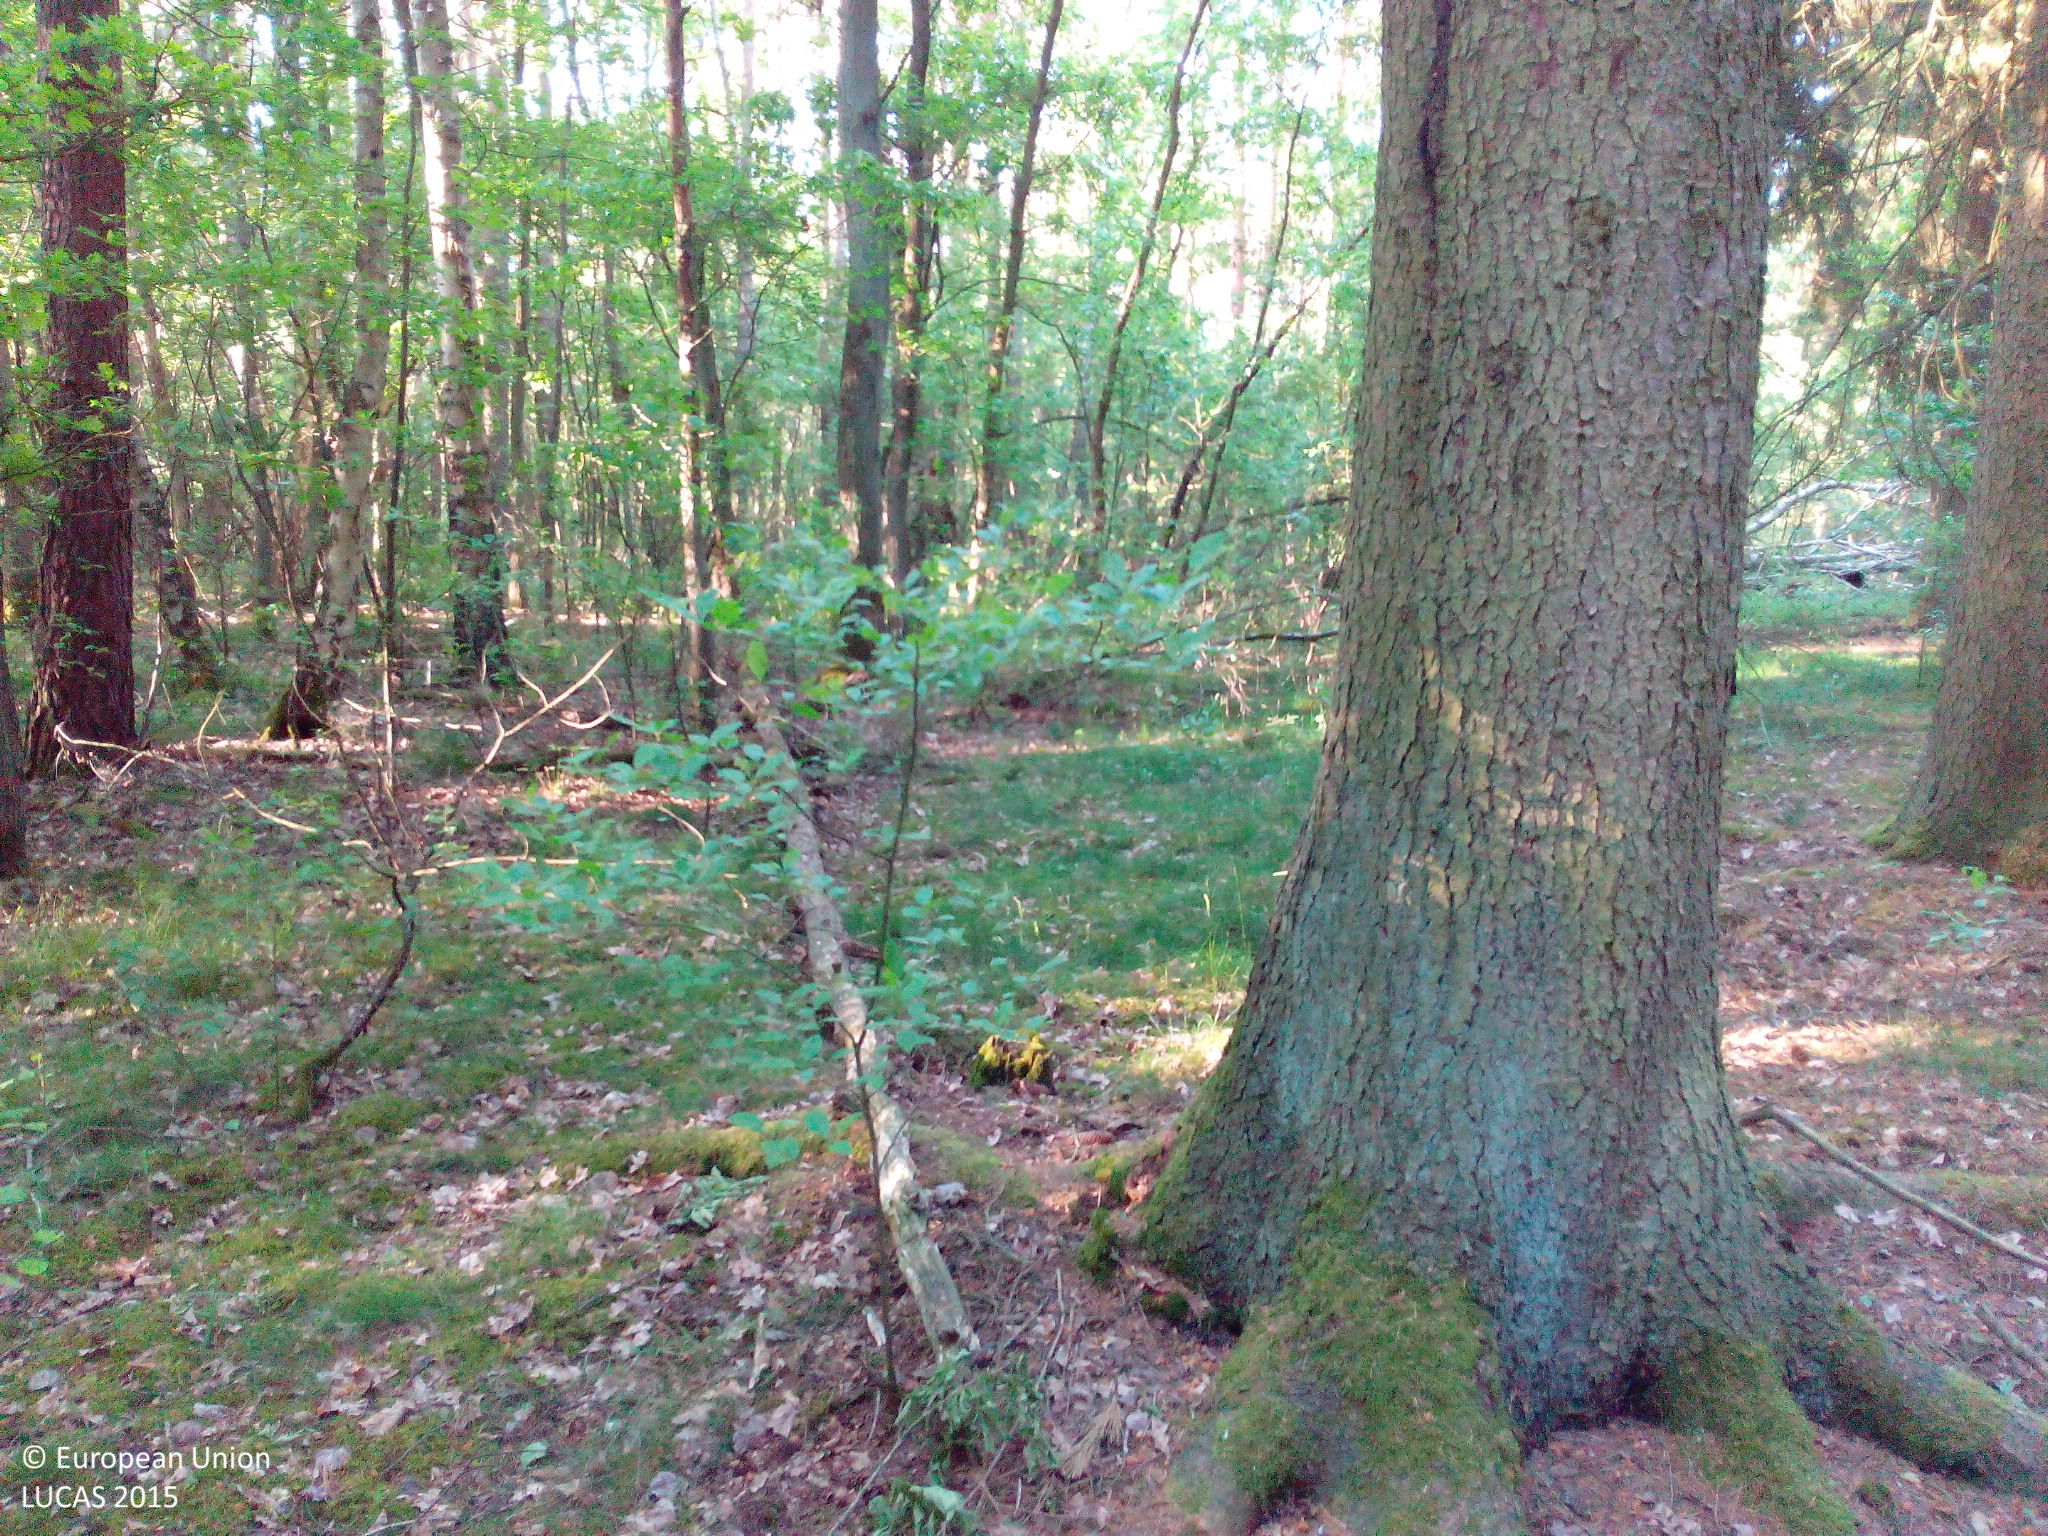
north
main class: Woodland
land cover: Pine dominated coniferous woodland
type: hemiboreal forest and nemoral coniferous forest and mixed broadleaved-coniferous forest
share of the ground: 50 - 75 %
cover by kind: coniferous forest trees 50 %, broadleaved forest trees 15 %, herbaceous plants 15 %, lichens and mosses 10 %, shrubs 5 %, unconsolidated bare surface 5 %
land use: Forestry
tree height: > 5 m
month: June
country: DE
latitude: 53.2353
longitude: 12.3516
